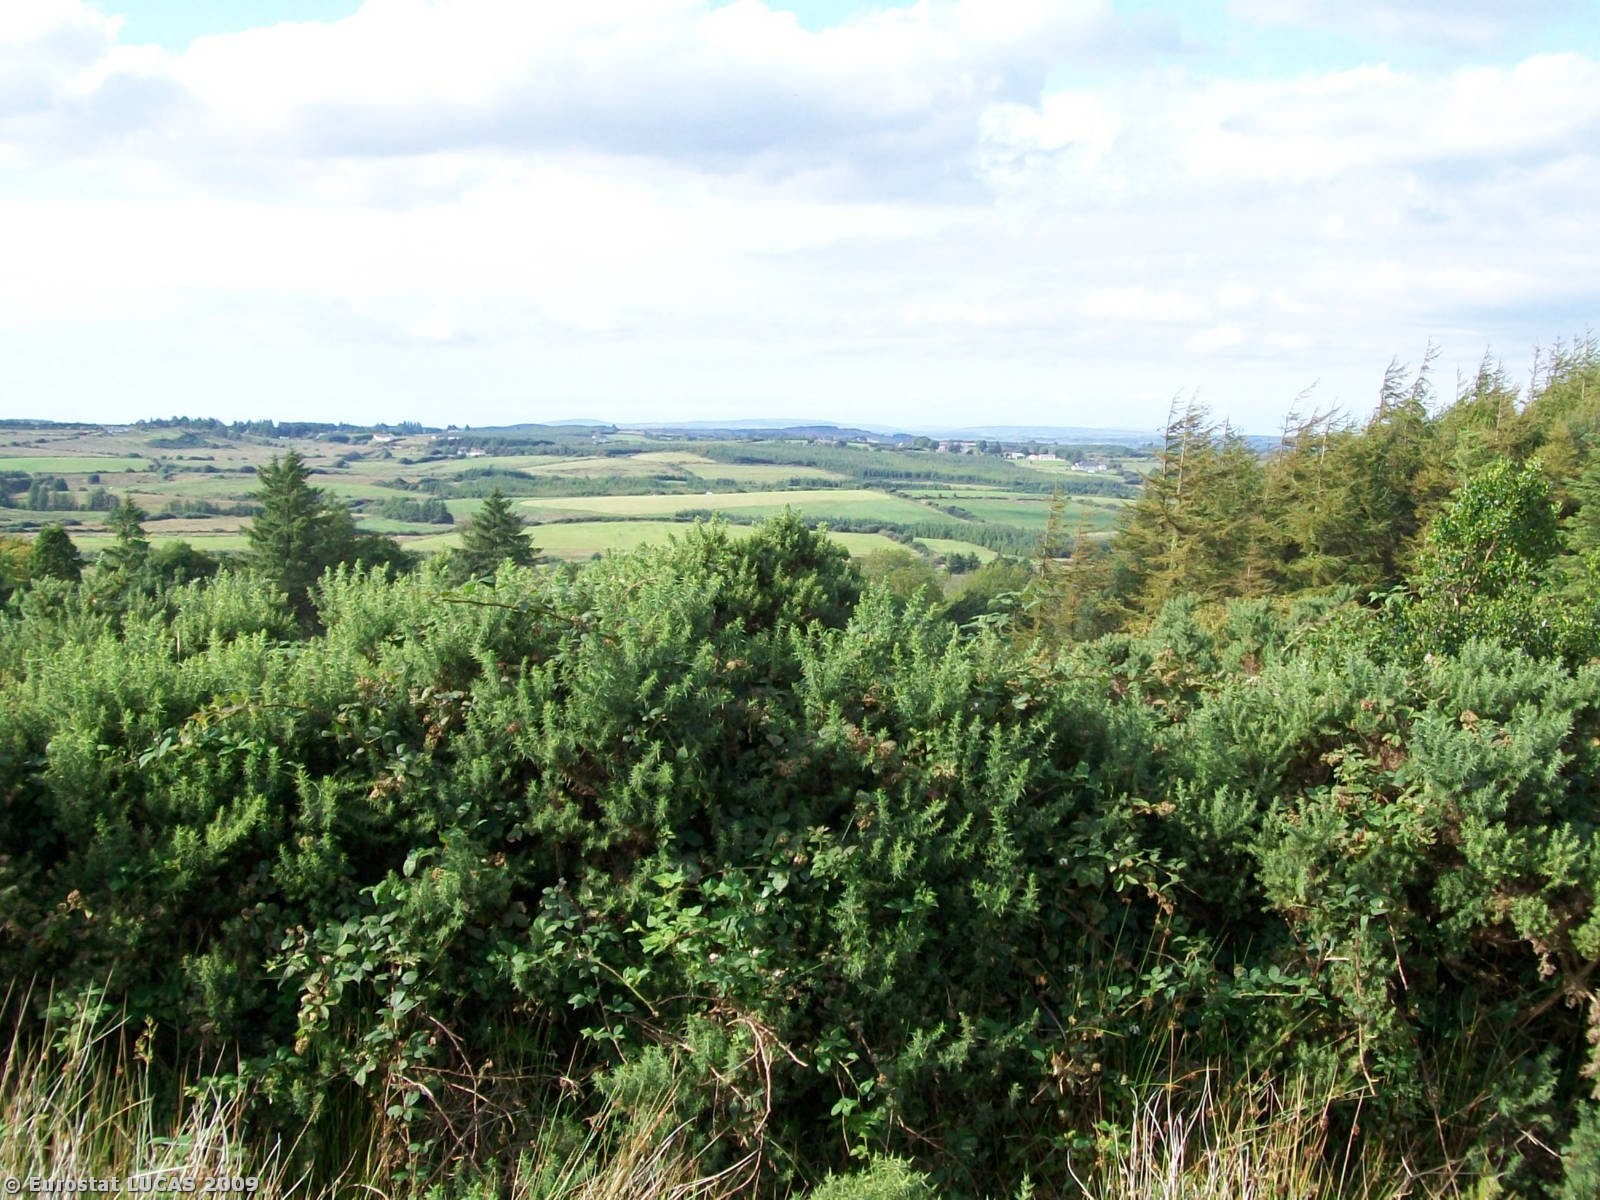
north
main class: Woodland
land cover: Coniferous woodland
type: plantations and self-sown exotic forest
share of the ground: > 75 %
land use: Forestry
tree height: > 5 m
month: August
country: IE
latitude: 52.7899
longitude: -9.1861
